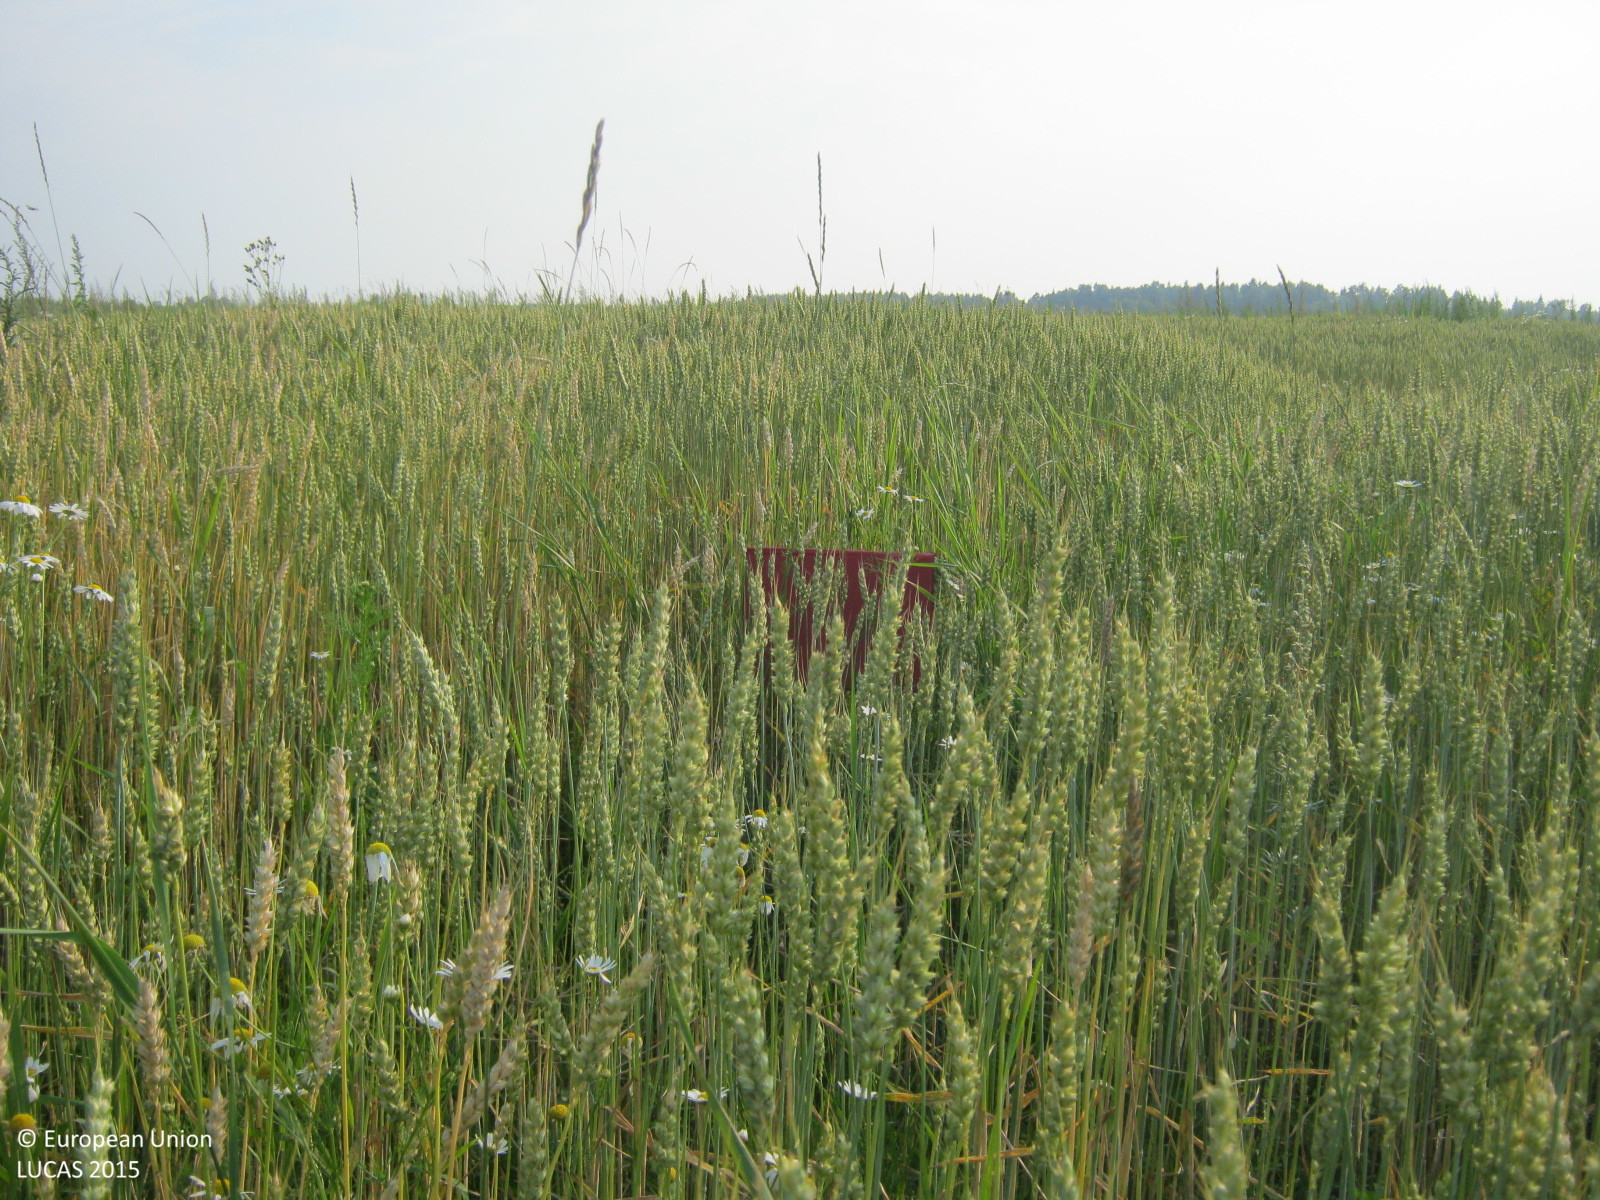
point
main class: Cropland
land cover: Common wheat
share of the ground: > 75 %
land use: Agriculture (excluding fallow land and kitchen gardens)
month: August
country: LV
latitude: 57.4267
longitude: 24.6673
